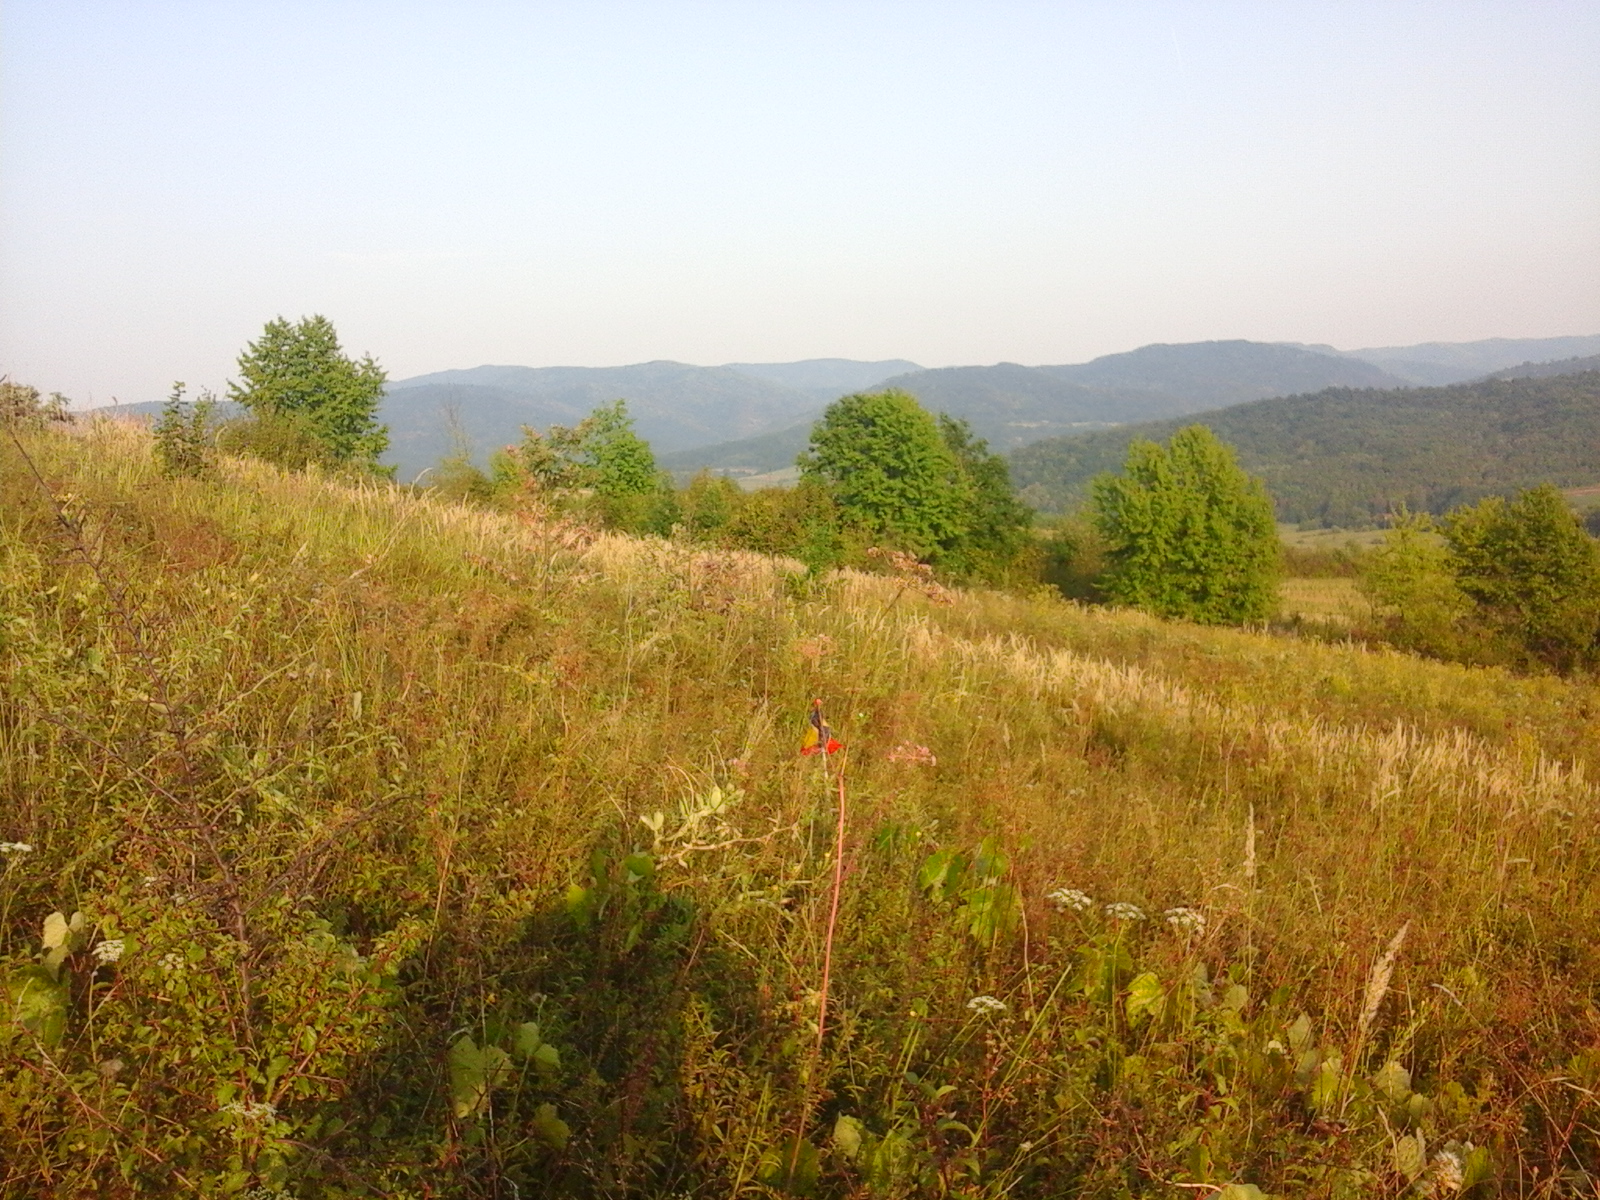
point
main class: Grassland
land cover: Spontaneously vegetated surfaces
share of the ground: > 75 %
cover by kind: herbaceous plants 100 %
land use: Fallow land
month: August
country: RO
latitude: 46.2389
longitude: 22.3022
